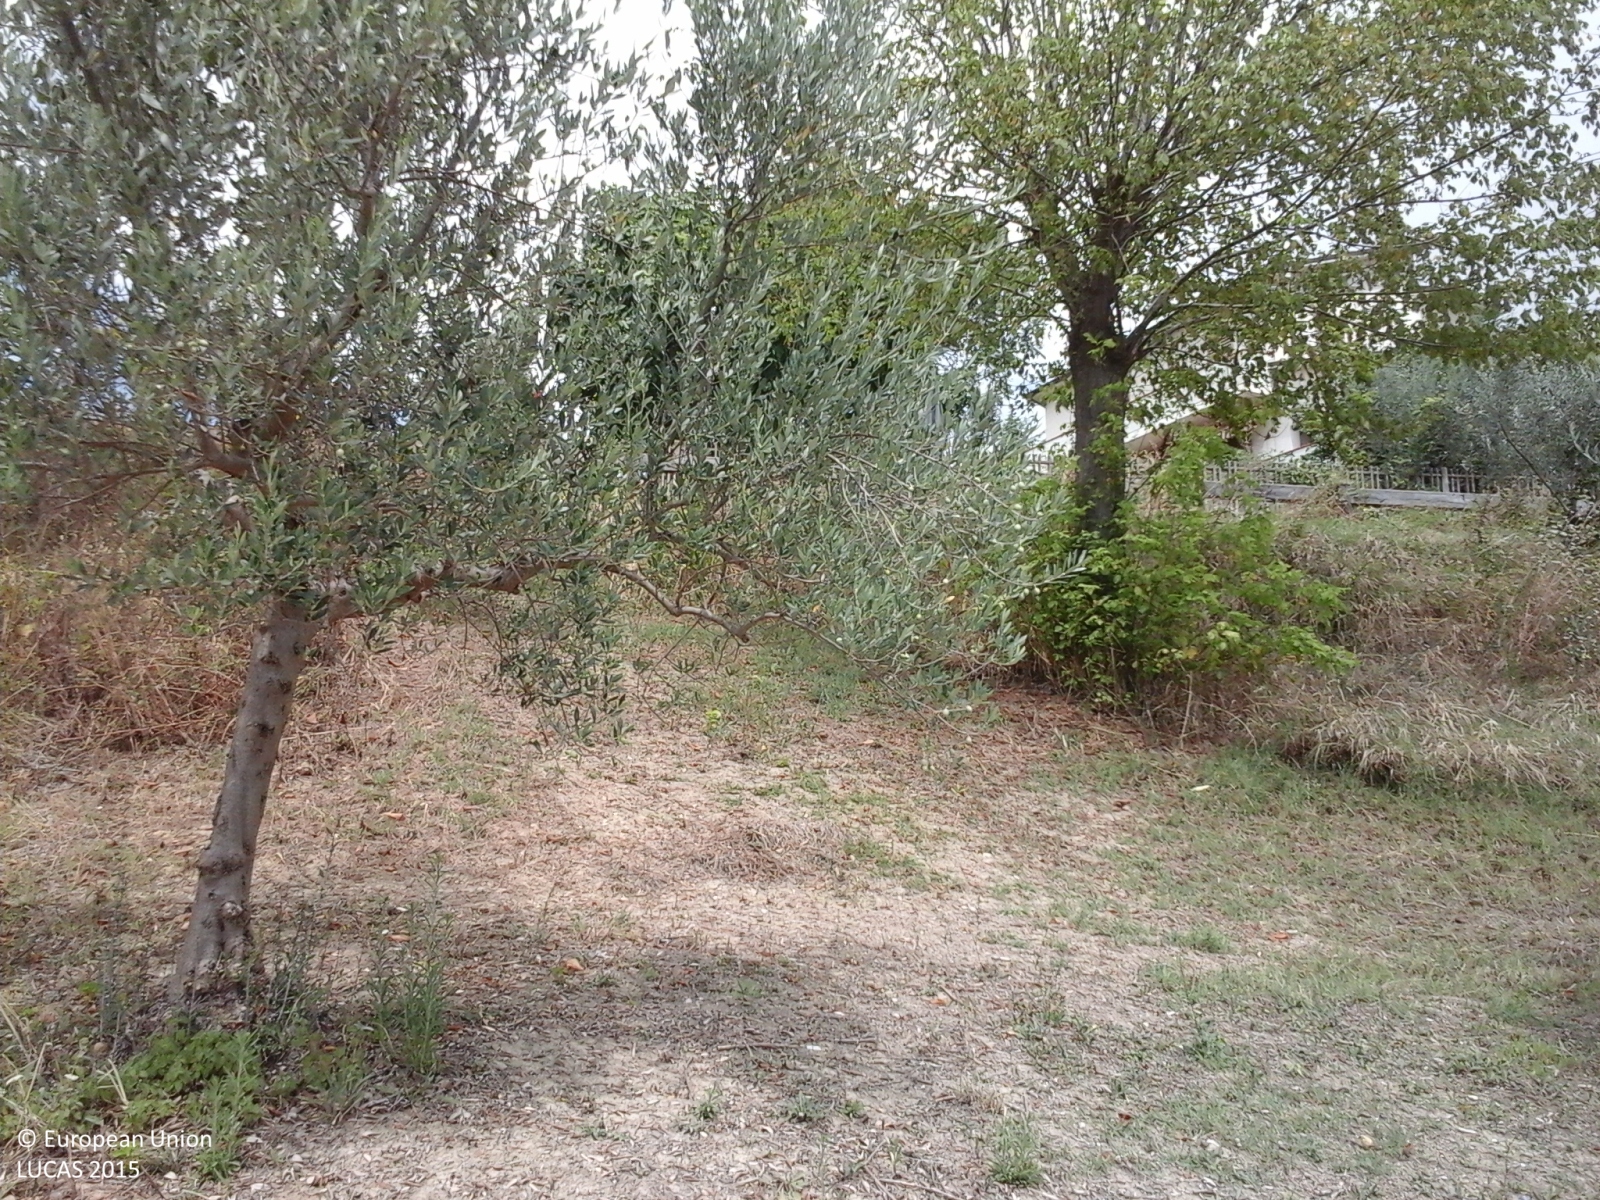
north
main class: Cropland
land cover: Olive groves
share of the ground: 25 - 50 %
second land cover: Spontaneously vegetated surfaces
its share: 25 - 50 %
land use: Agriculture (excluding fallow land and kitchen gardens)
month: August
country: IT
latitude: 42.5960
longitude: 13.9250
